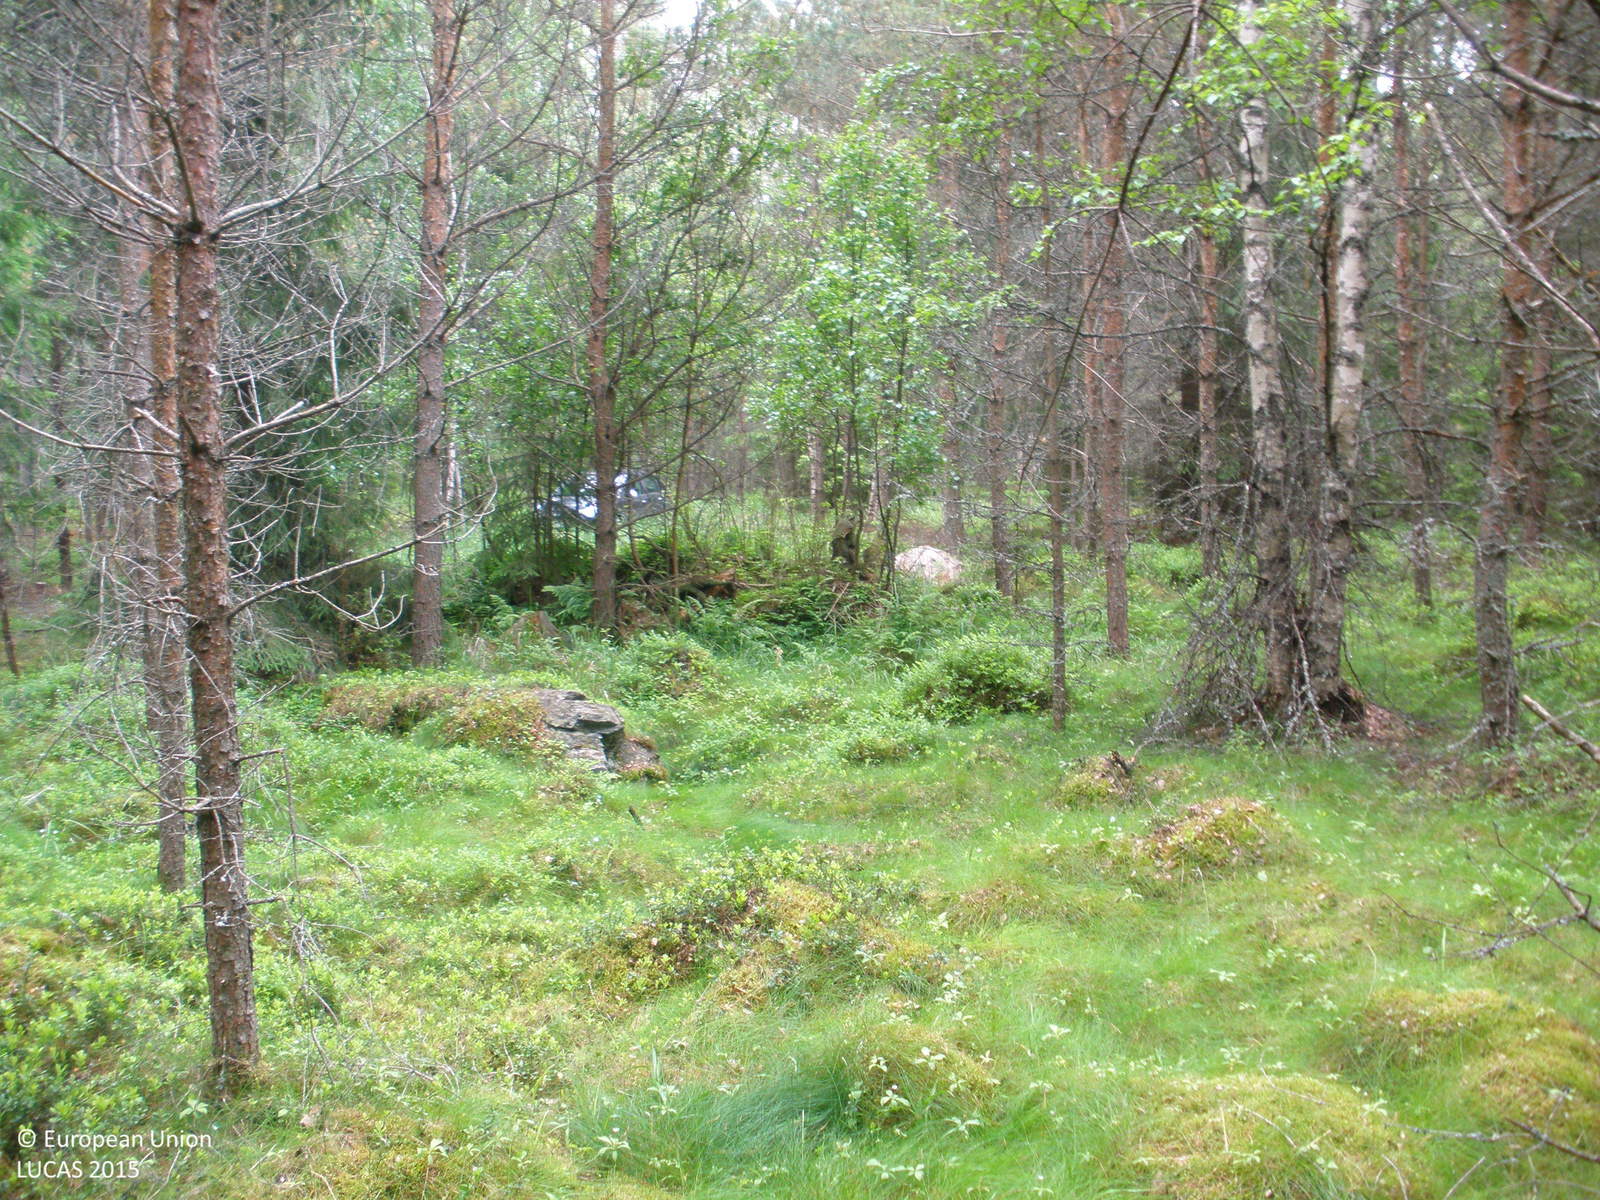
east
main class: Woodland
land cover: Pine dominated mixed woodland
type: boreal forest
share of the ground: > 75 %
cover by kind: coniferous forest trees 50 %, broadleaved forest trees 25 %, herbaceous plants 15 %, shrubs 5 %, lichens and mosses 5 %
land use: Forestry
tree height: > 5 m
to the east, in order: Pine dominated mixed woodland; Tracks; Pine dominated mixed woodland; Spruce dominated mixed woodland; Ditches and canals; Shruby margins; Temporary grasslands; Ditches and canals; Grassland with sparse tree/shrub cover
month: June
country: FI
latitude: 61.0452
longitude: 23.1311
